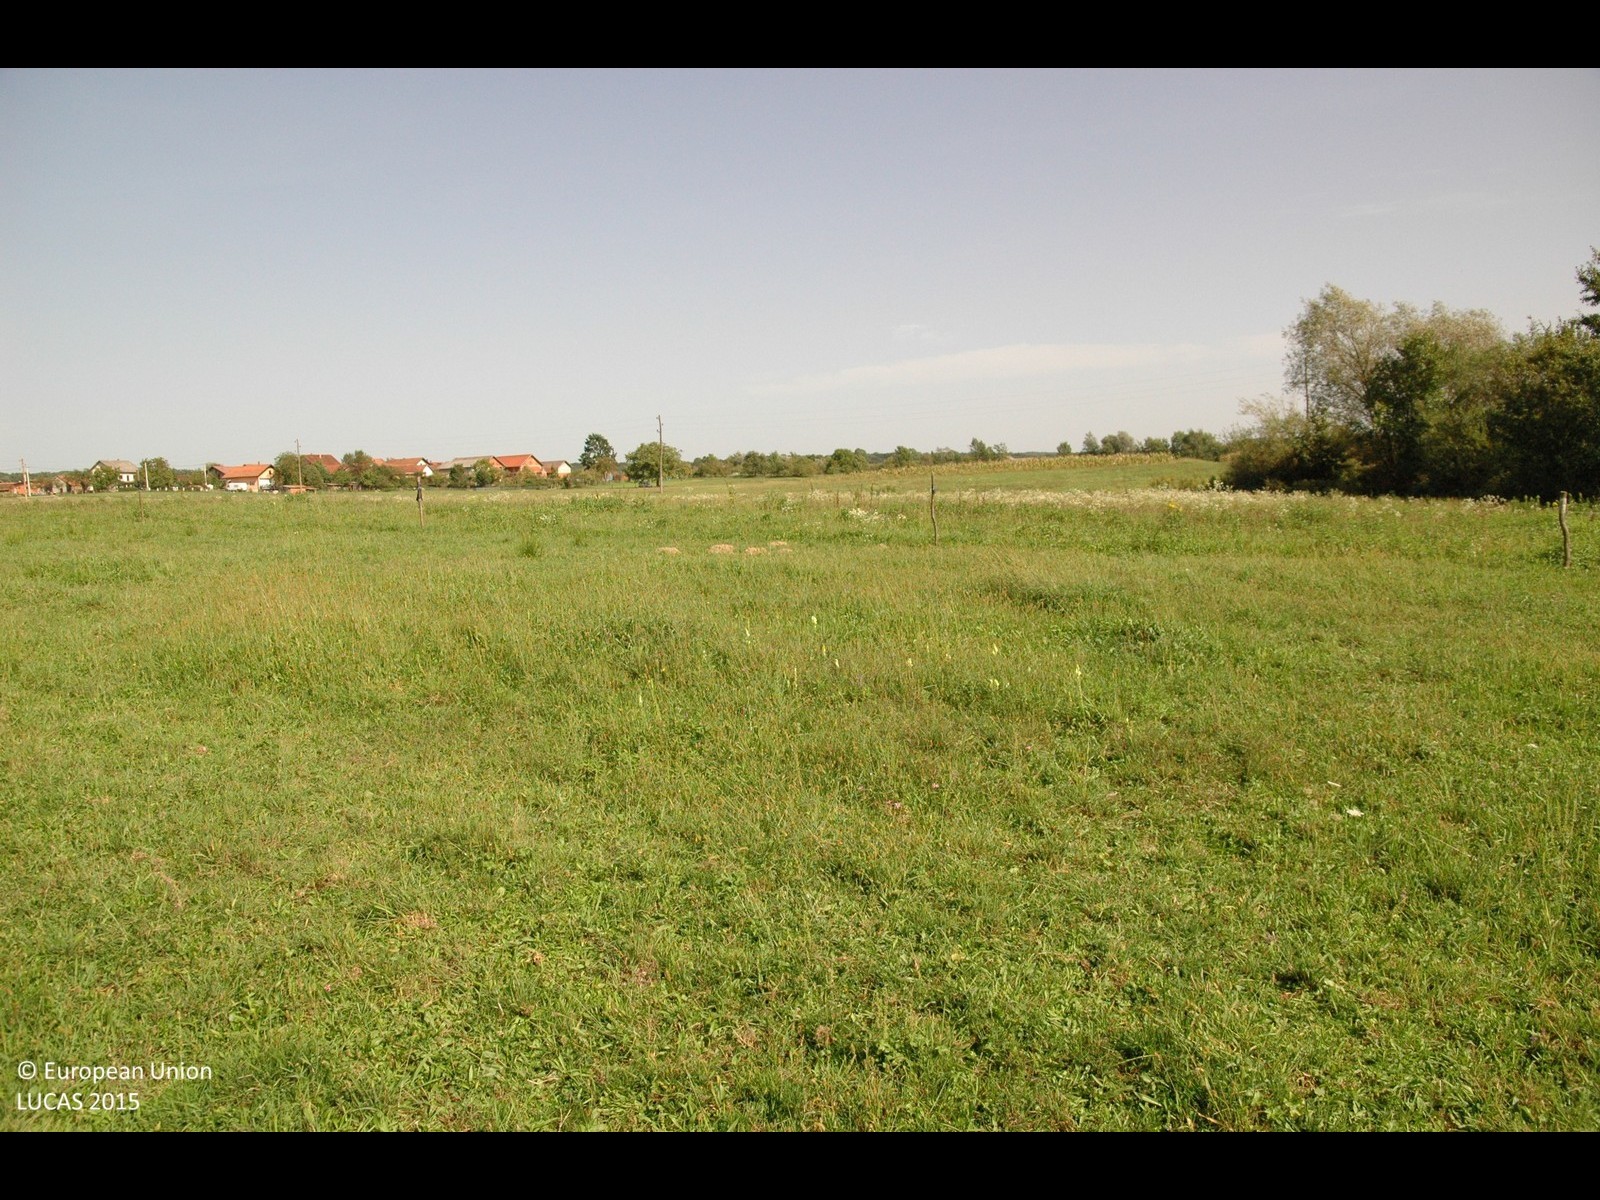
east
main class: Grassland
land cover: Grassland without tree/shrub cover
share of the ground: > 75 %
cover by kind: herbaceous plants 100 %
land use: Agriculture (excluding fallow land and kitchen gardens)
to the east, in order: Grassland without tree/shrub cover; Fences; Grassland without tree/shrub cover; Electric lines; Grassland without tree/shrub cover; Maize; Grassland without tree/shrub cover; Fences; Grassland without tree/shrub cover
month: September
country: HR
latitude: 45.6142
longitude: 15.8318
